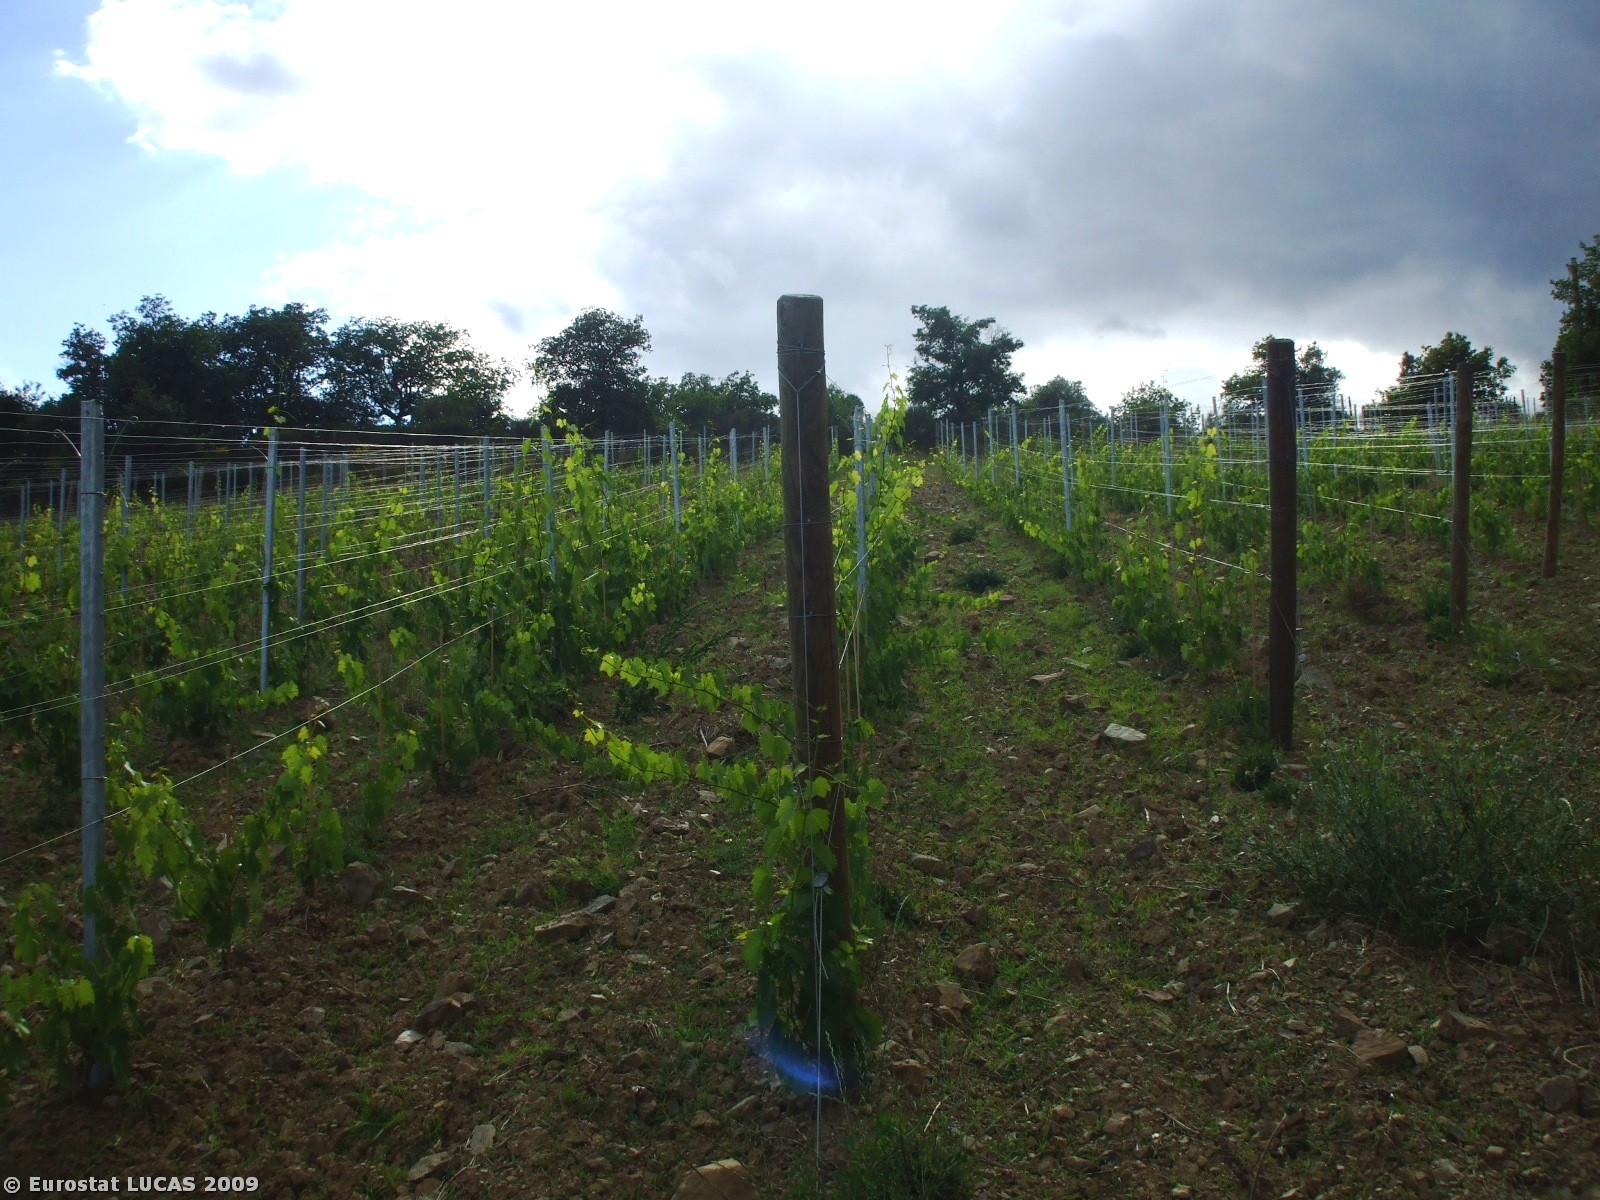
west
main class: Cropland
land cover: Vineyards
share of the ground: 10 - 25 %
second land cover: Grassland with sparse tree/shrub cover
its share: > 75 %
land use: Agriculture (excluding fallow land and kitchen gardens)
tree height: < 5 m
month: June
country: IT
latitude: 43.3804
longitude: 11.6863
